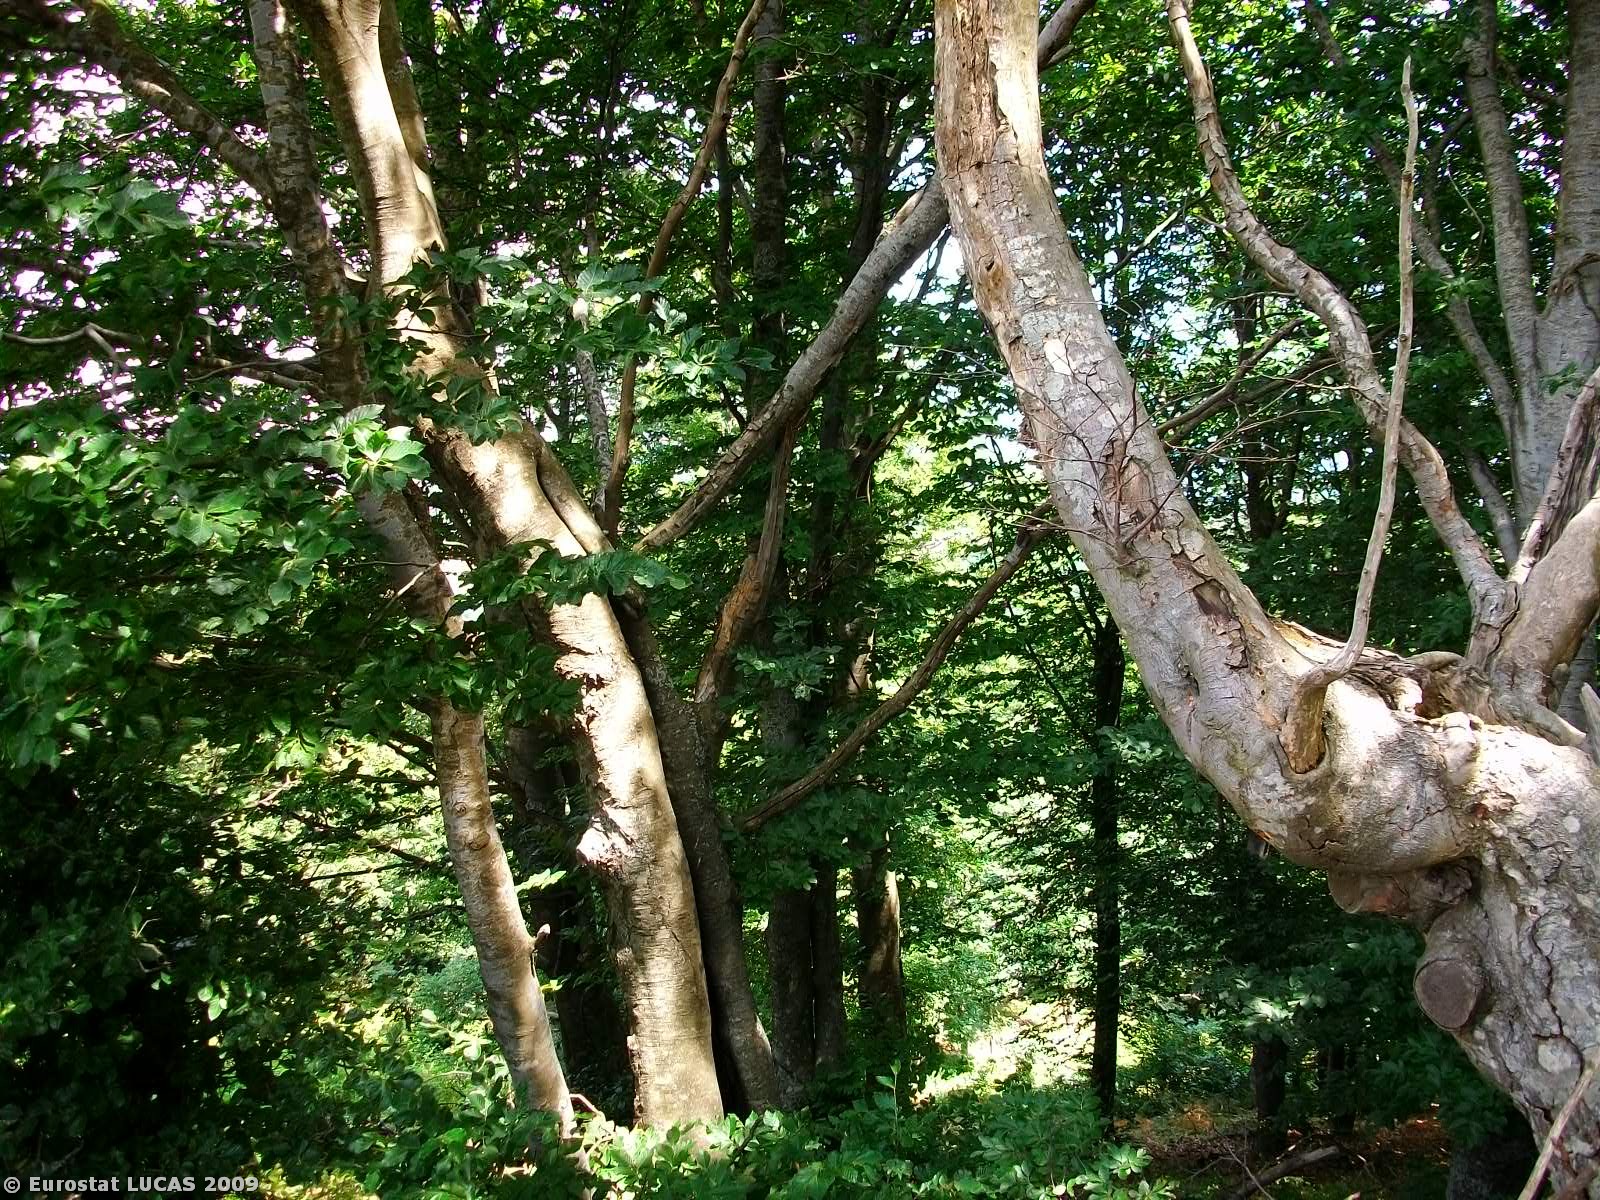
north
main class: Woodland
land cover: Broadleaved woodland
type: mountainous beech forest
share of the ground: 50 - 75 %
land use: Forestry
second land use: Agriculture (excluding fallow land and kitchen gardens)
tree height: > 5 m
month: June
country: GR
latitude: 41.1579
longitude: 25.8499
